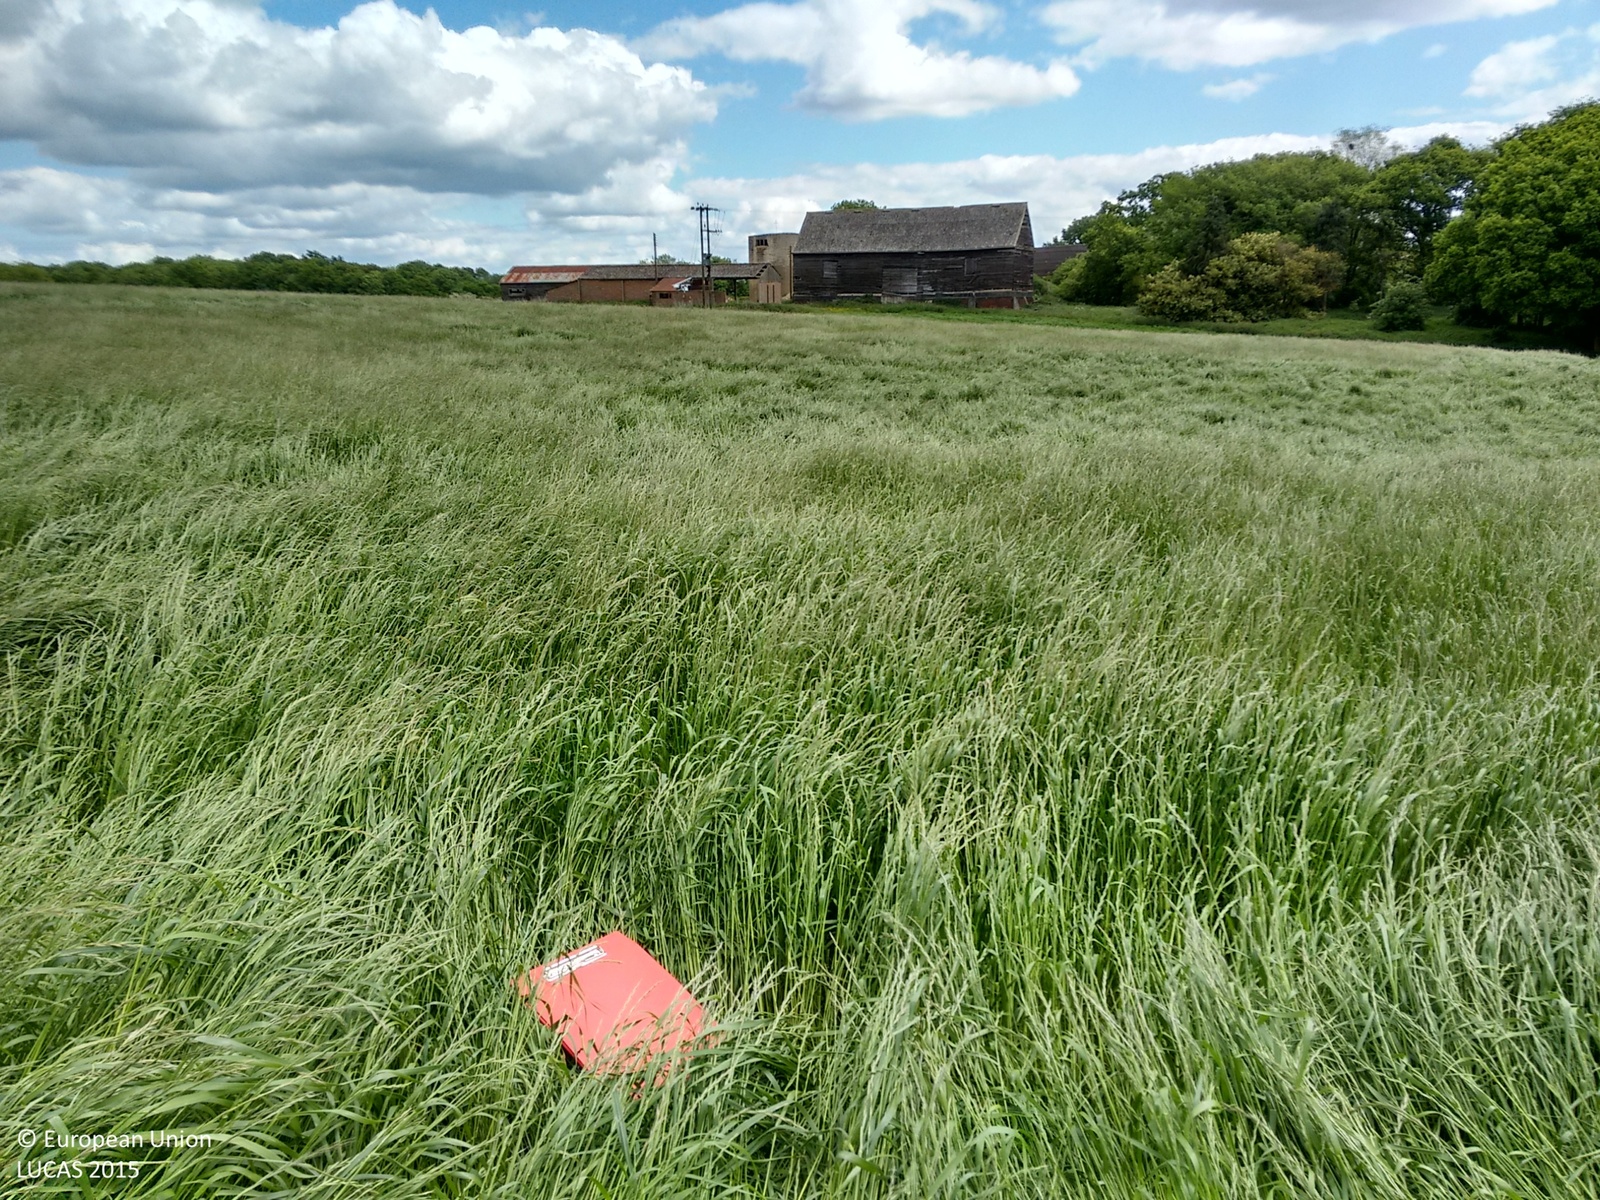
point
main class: Cropland
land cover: Temporary grasslands
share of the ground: > 75 %
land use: Agriculture (excluding fallow land and kitchen gardens)
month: May
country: GB
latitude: 51.8880
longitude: 0.0734
